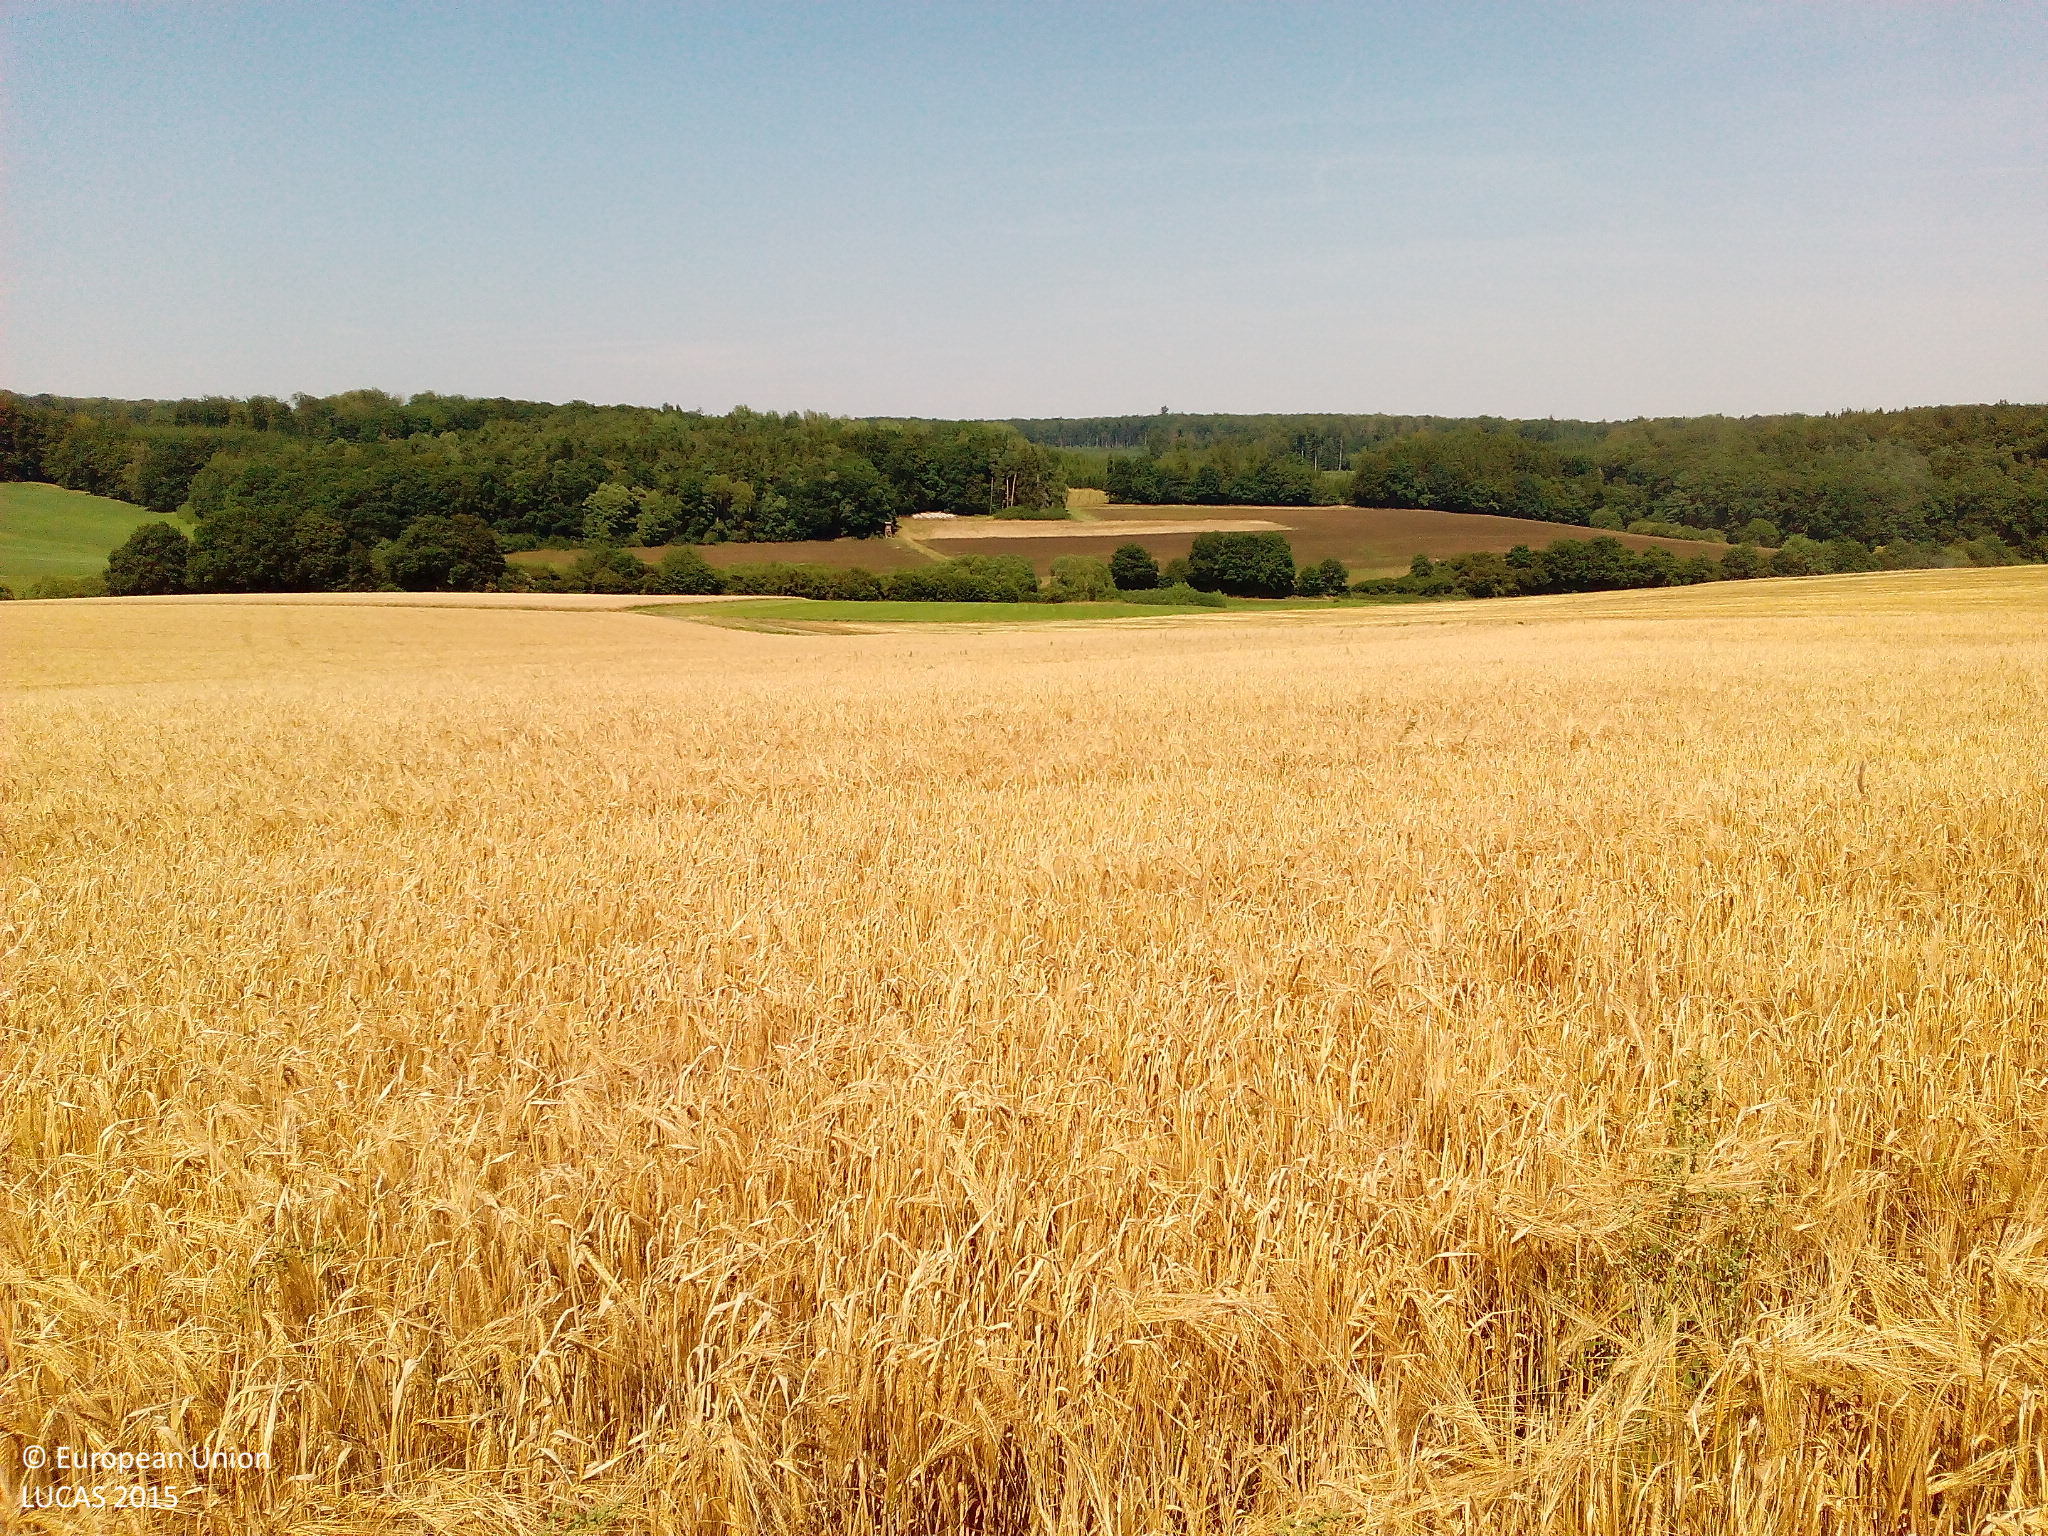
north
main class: Cropland
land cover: Barley
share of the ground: > 75 %
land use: Agriculture (excluding fallow land and kitchen gardens)
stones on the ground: < 10 %
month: August
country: DE
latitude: 50.8285
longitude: 9.1626
